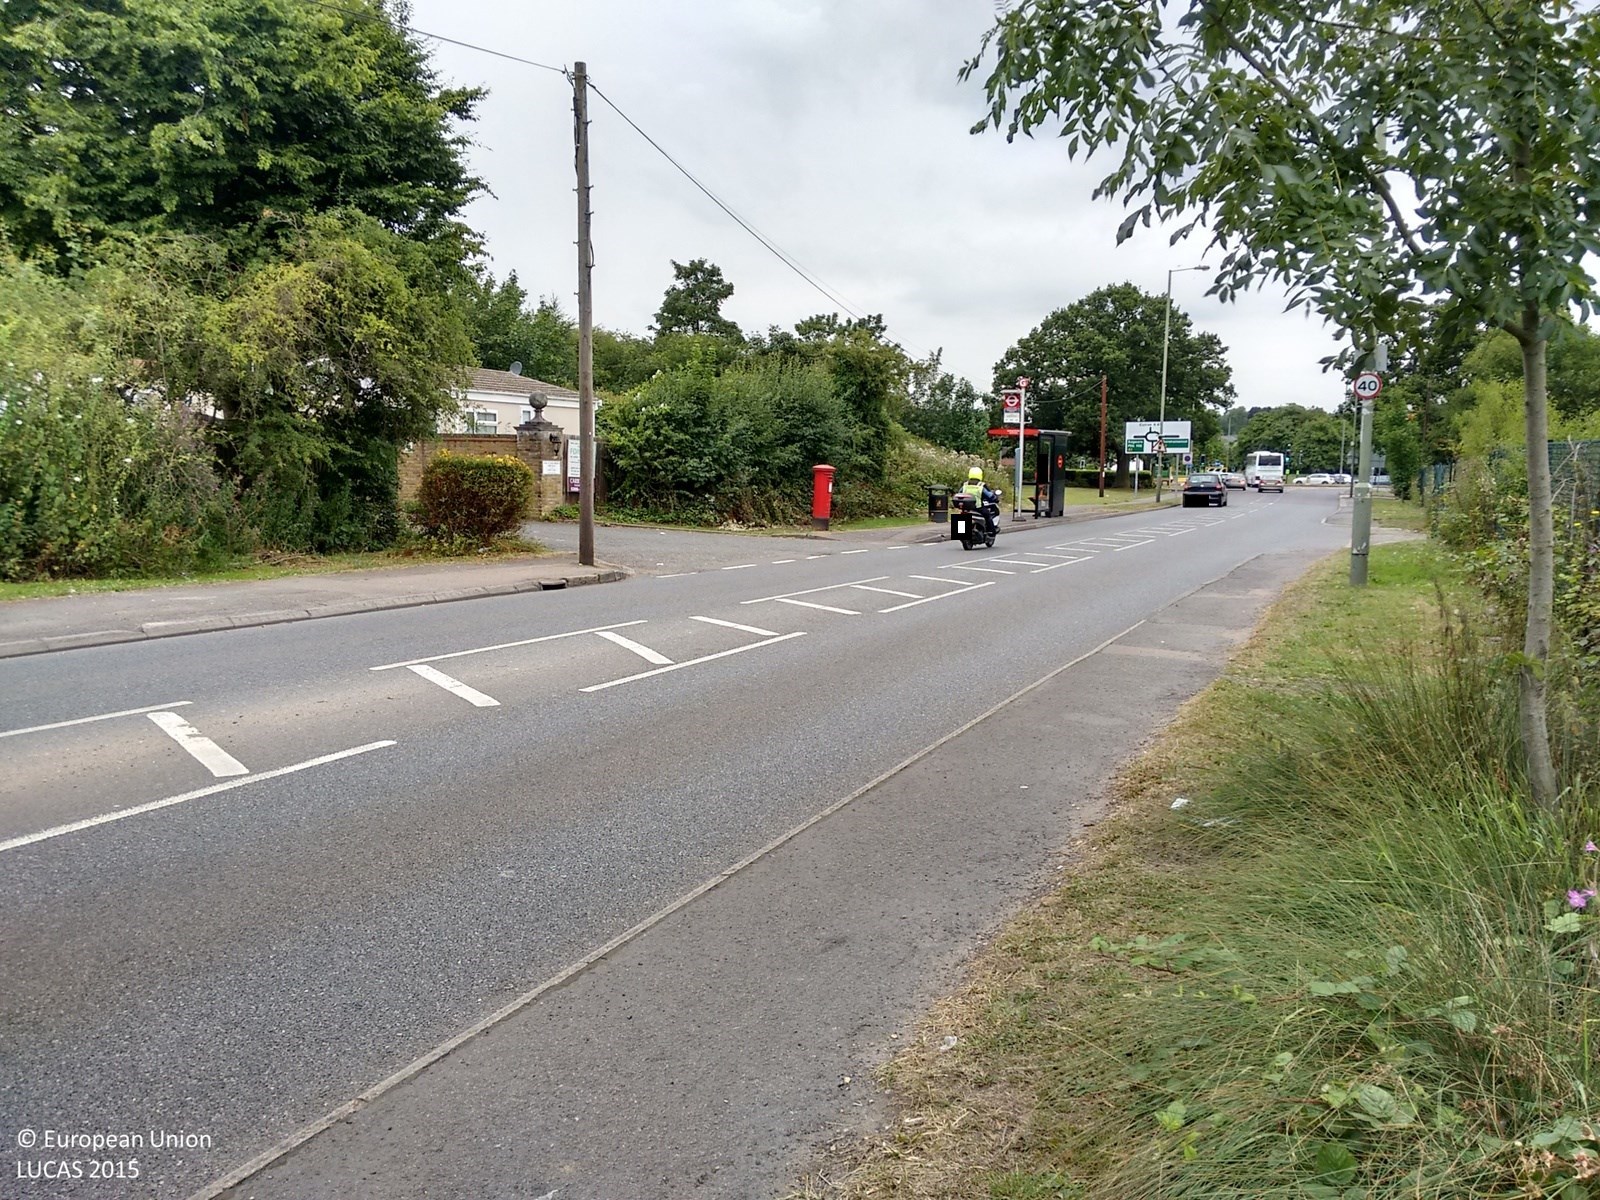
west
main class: Woodland
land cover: Broadleaved woodland
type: mesophytic deciduous forest
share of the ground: 25 - 50 %
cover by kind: broadleaved forest trees 50 %, shrubs 40 %, herbaceous plants 10 %
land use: Abandoned areas
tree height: > 5 m
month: July
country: GB
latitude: 51.6424
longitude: -0.2522
